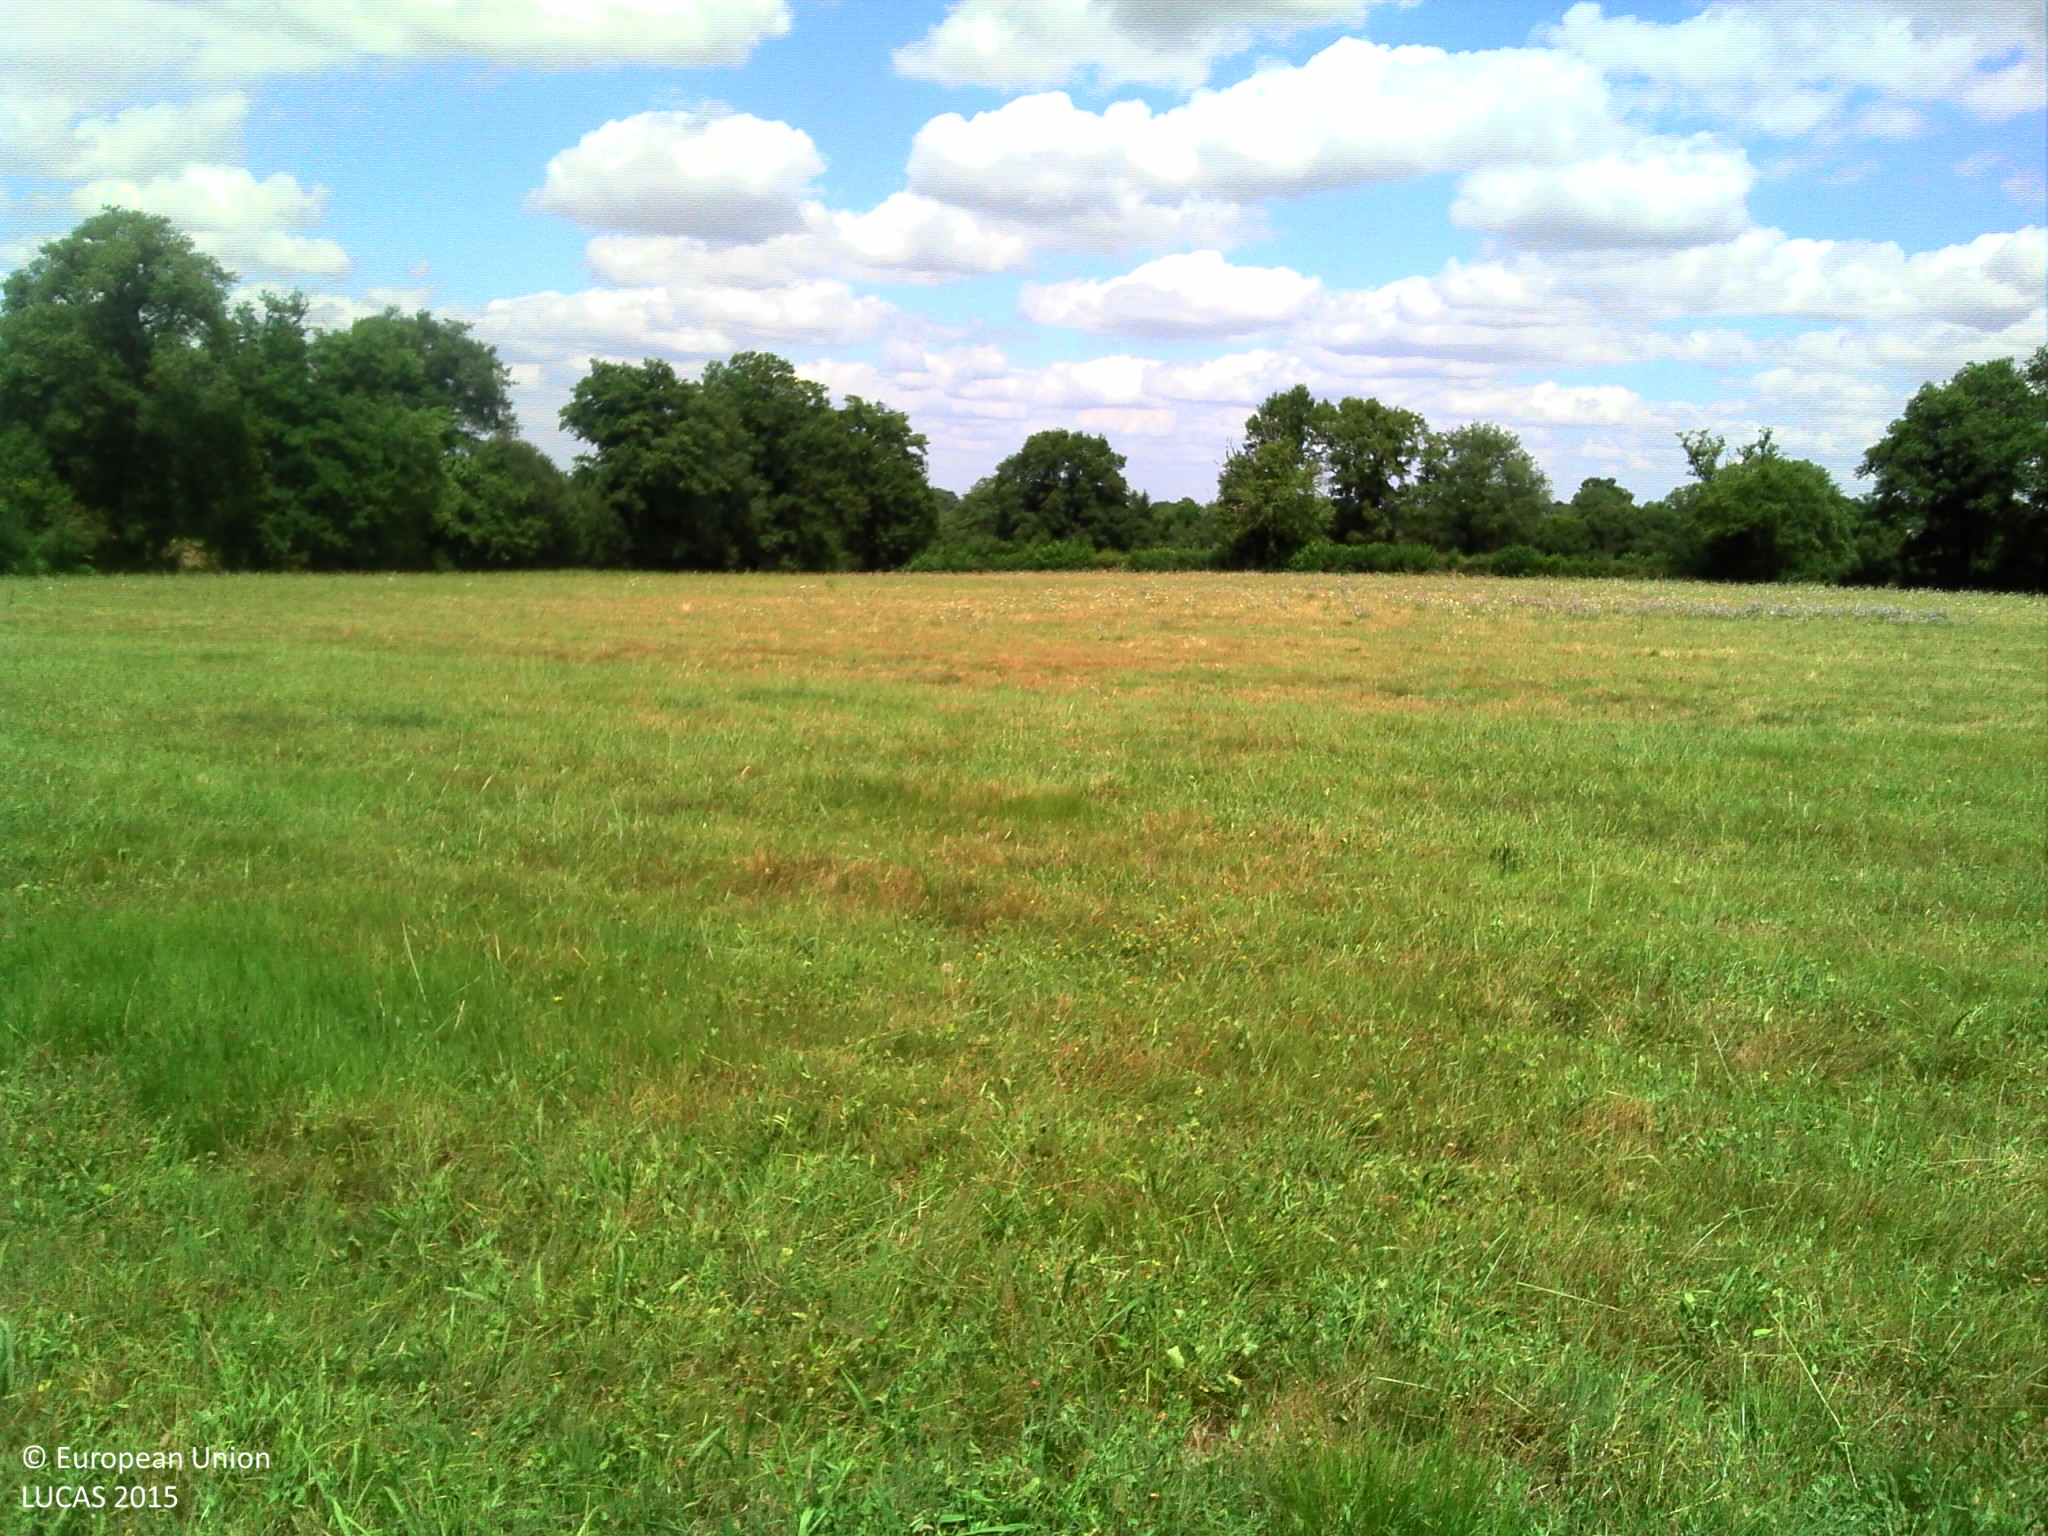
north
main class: Grassland
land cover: Grassland without tree/shrub cover
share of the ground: > 75 %
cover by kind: herbaceous plants 100 %
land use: Agriculture (excluding fallow land and kitchen gardens)
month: July
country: FR
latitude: 46.4637
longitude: 2.1938
